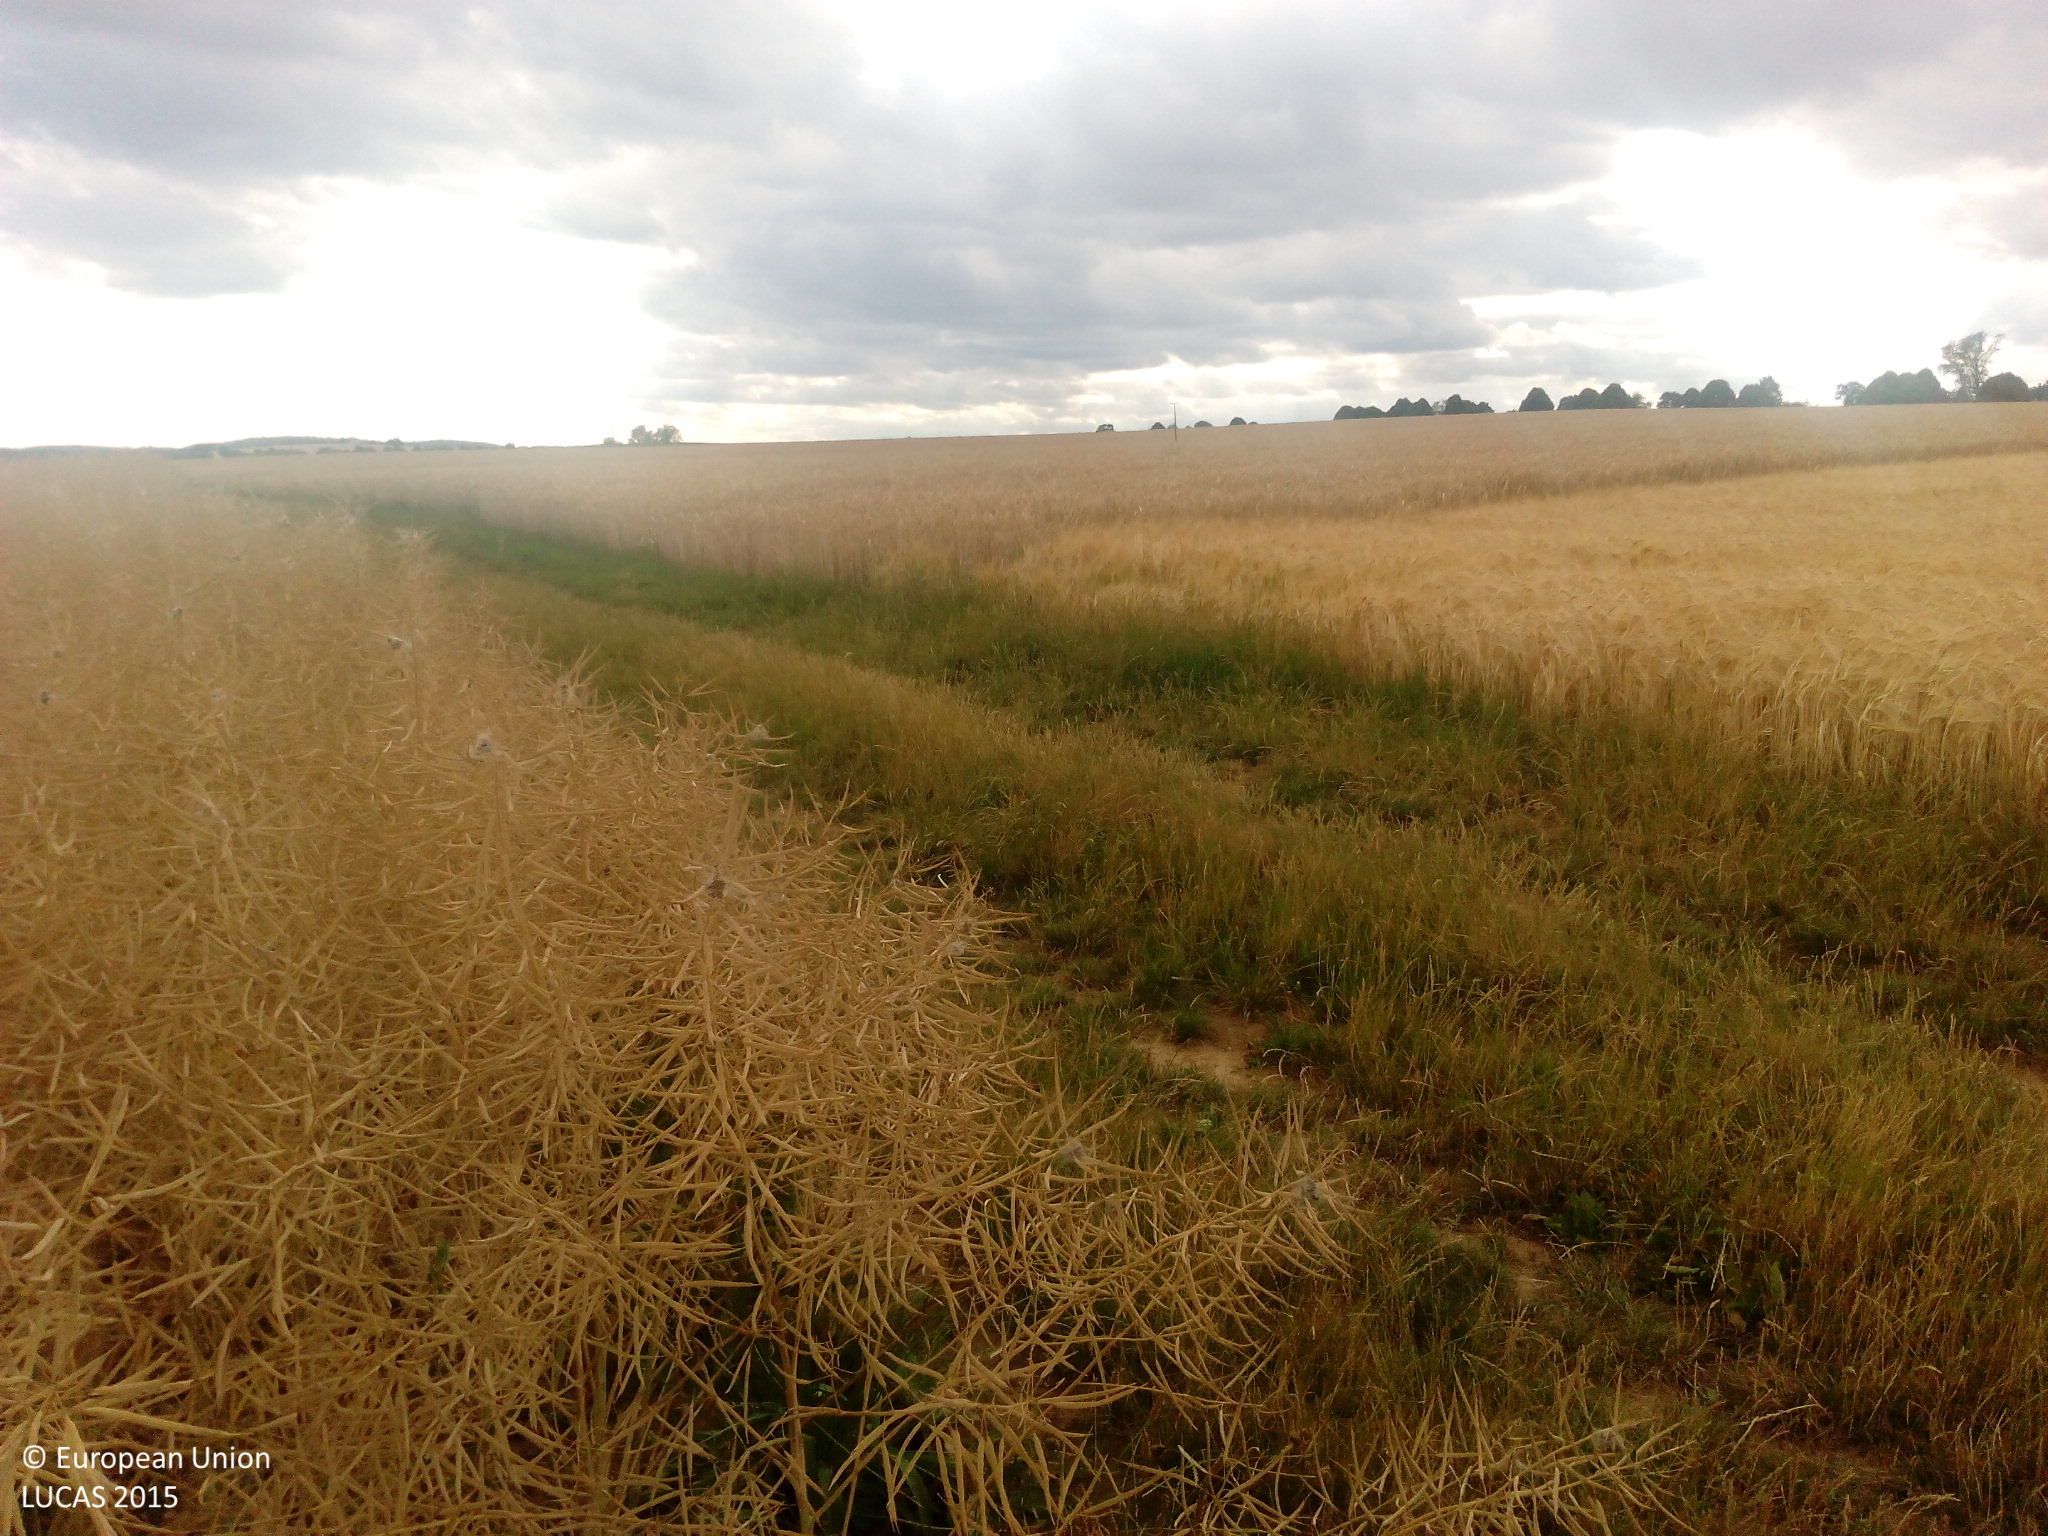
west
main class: Cropland
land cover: Rape and turnip rape
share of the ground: > 75 %
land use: Agriculture (excluding fallow land and kitchen gardens)
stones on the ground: < 10 %
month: July
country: DE
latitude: 49.6998
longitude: 8.0455
